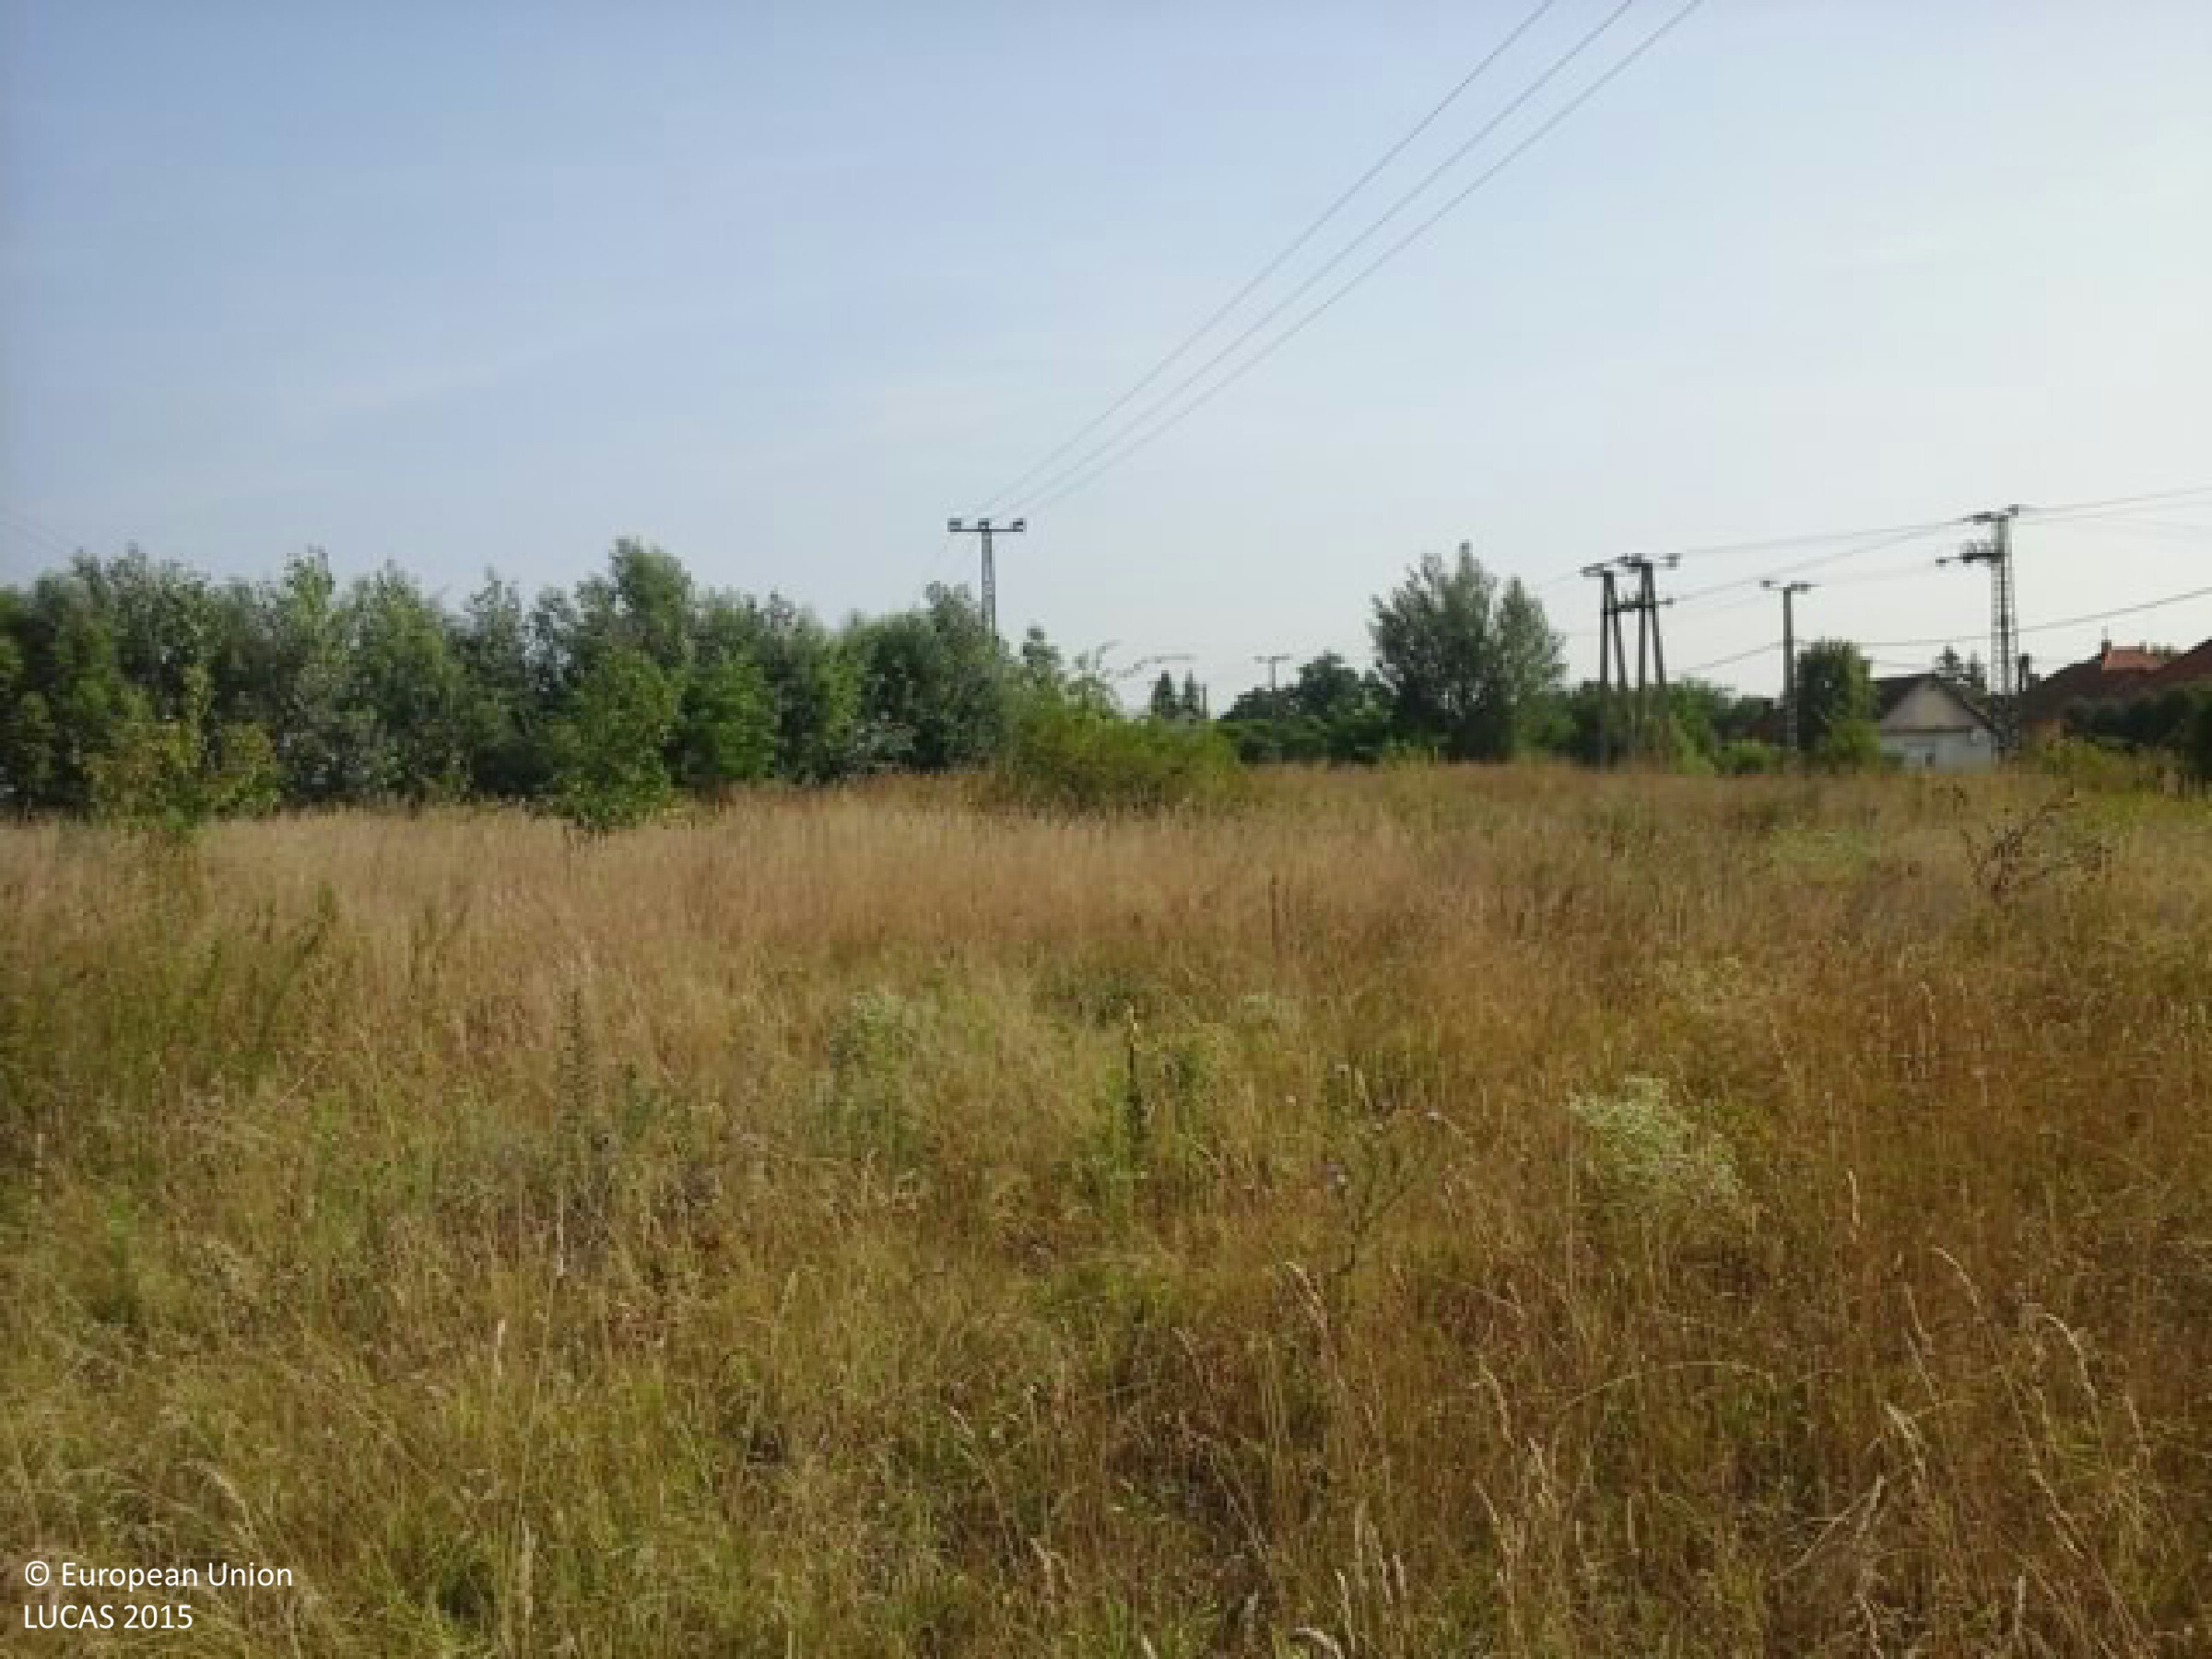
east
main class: Cropland
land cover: Cherry fruit
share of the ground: 50 - 75 %
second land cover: Other bare soil
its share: > 75 %
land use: Agriculture (excluding fallow land and kitchen gardens)
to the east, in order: Cherry fruit; Other bare soil; Fences; Grassland without tree/shrub cover; Electric lines; Grassland with sparse tree/shrub cover; Tracks; Electric lines; Grassland without tree/shrub cover; Artificial constructions in urban areas
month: July
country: HU
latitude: 47.5988
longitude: 20.2567
